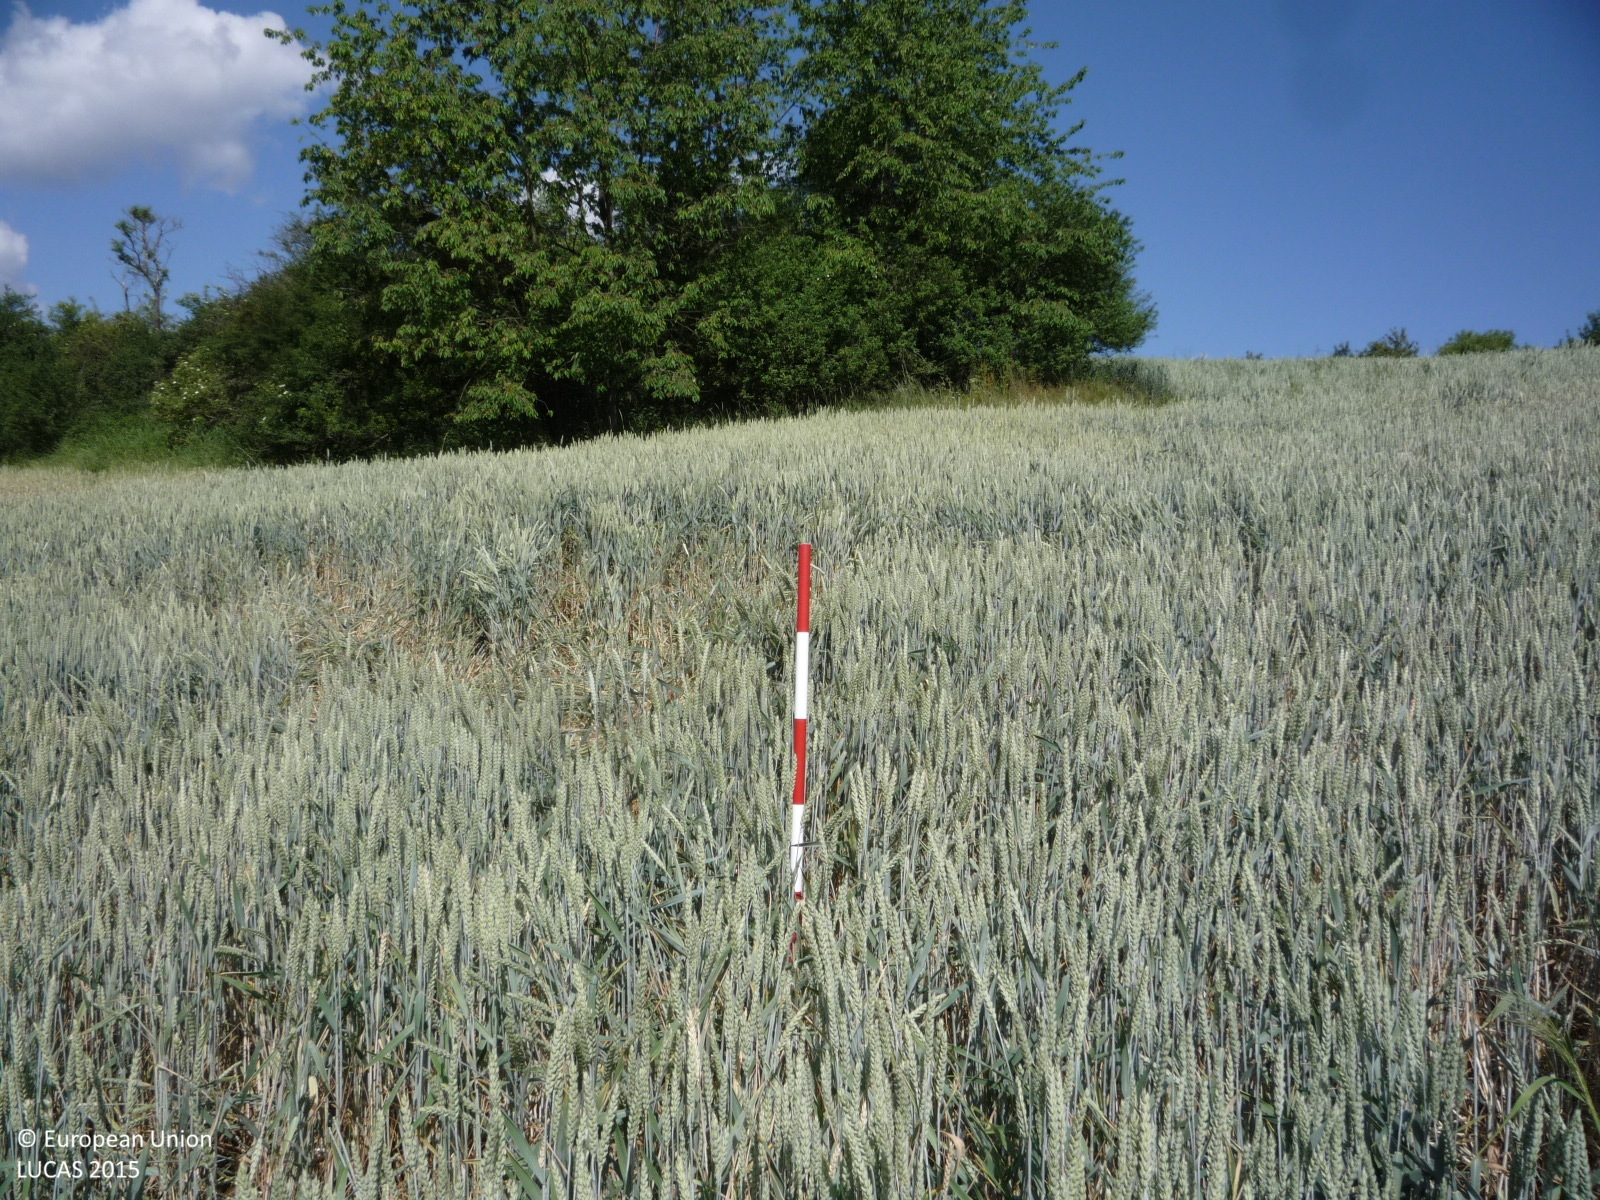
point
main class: Cropland
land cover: Common wheat
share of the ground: > 75 %
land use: Agriculture (excluding fallow land and kitchen gardens)
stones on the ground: < 10 %
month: June
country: CZ
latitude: 49.7448
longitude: 15.1237
